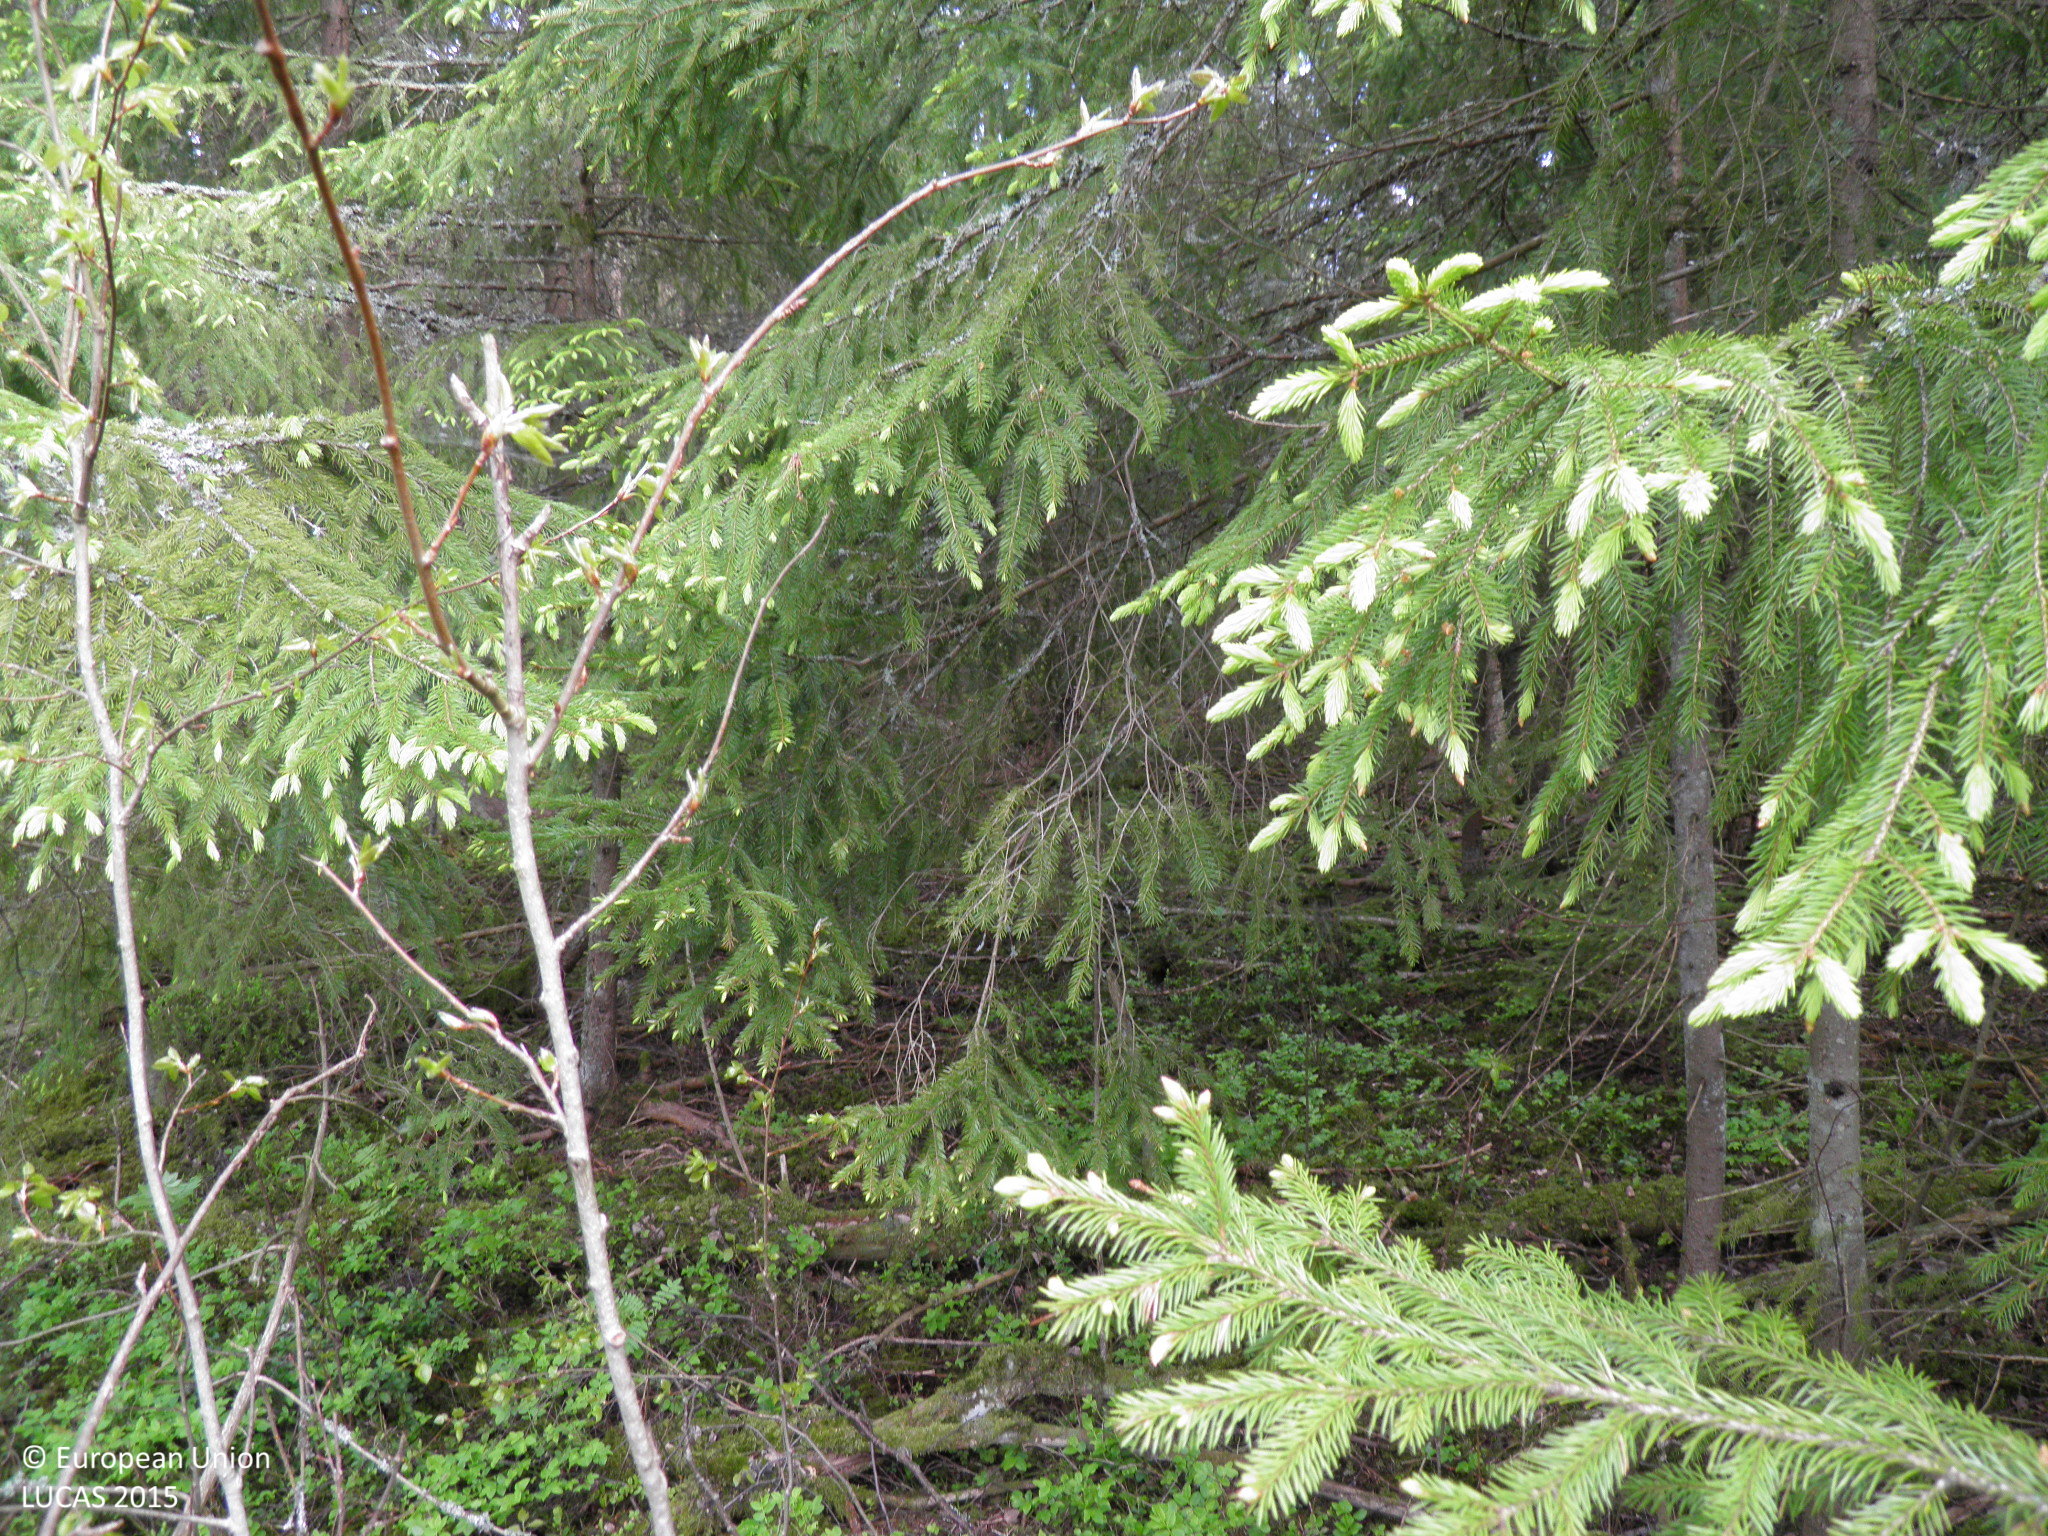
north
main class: Woodland
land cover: Spruce dominated mixed woodland
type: boreal forest
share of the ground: > 75 %
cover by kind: coniferous forest trees 65 %, broadleaved forest trees 25 %, shrubs 10 %
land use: Forestry
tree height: > 5 m
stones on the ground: < 10 %
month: May
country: FI
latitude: 60.3724
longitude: 22.2721
